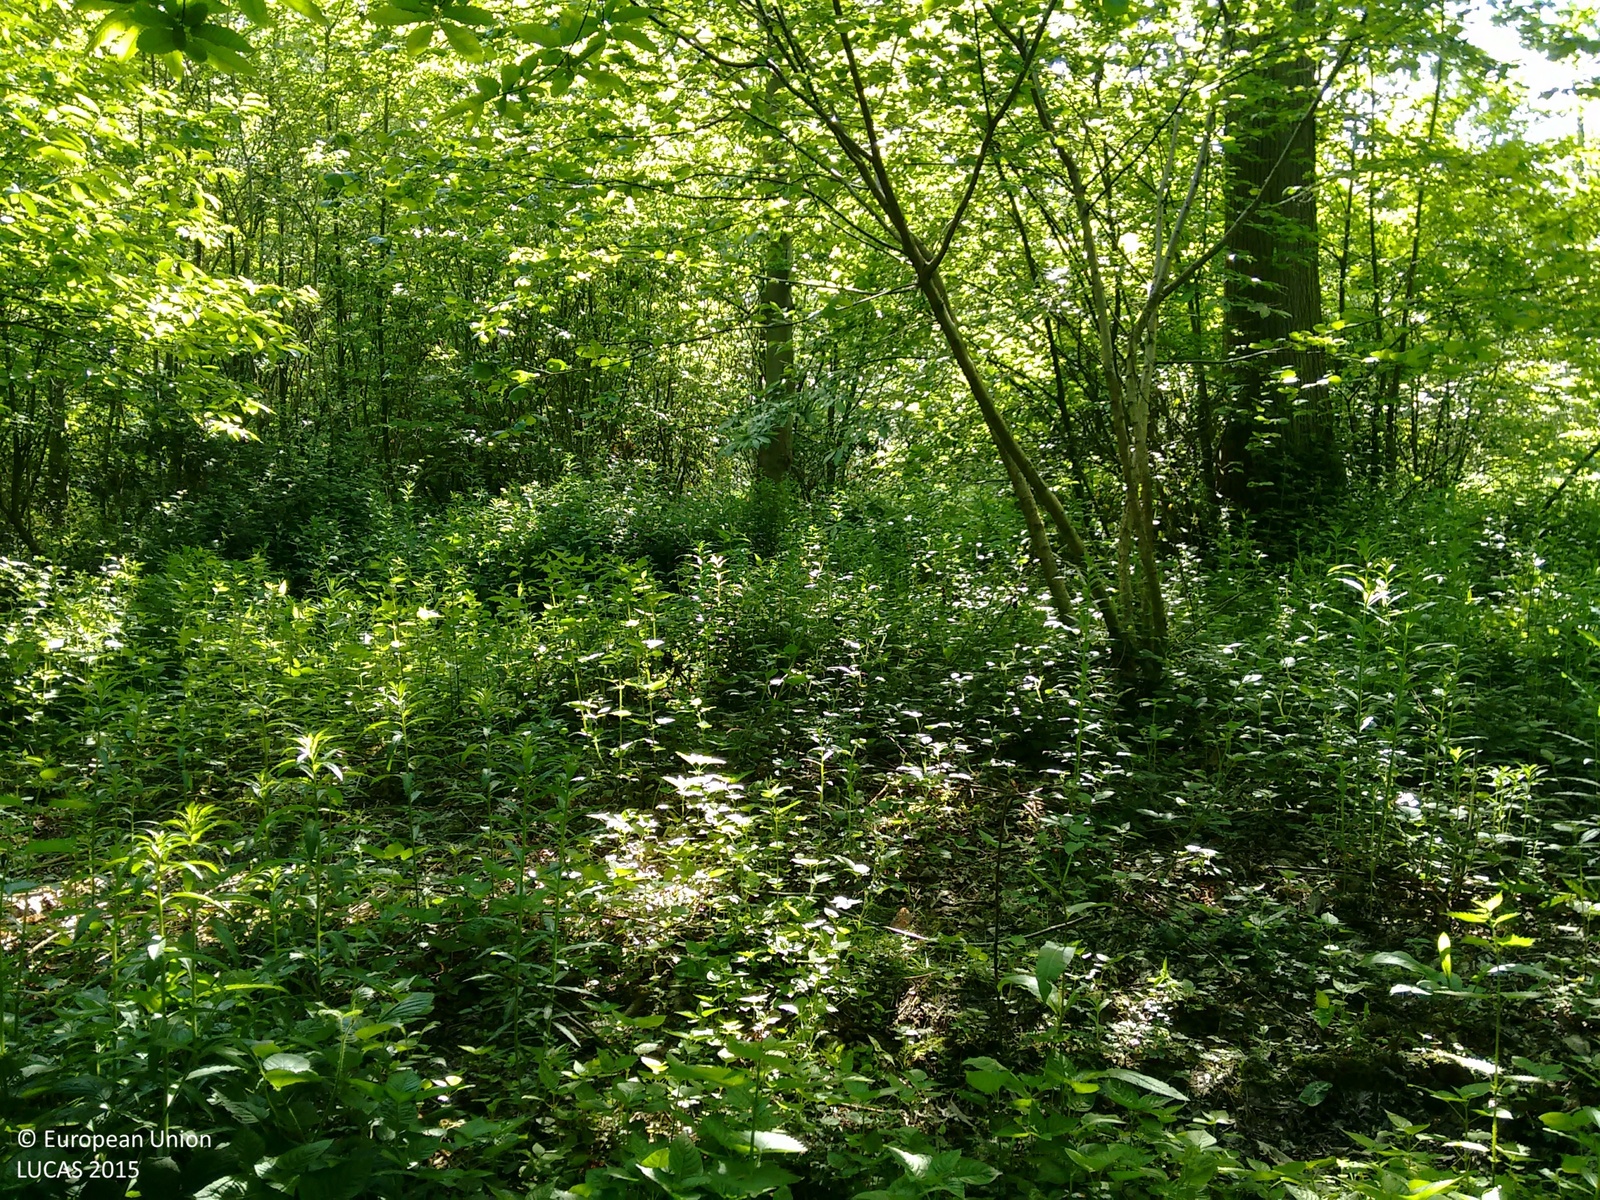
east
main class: Woodland
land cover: Broadleaved woodland
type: exotic forest
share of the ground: > 75 %
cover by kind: broadleaved forest trees 50 %, shrubs 40 %, herbaceous plants 10 %
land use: Forestry
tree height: > 5 m
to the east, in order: Broadleaved woodland
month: May
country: GB
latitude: 51.2183
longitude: 1.2018
